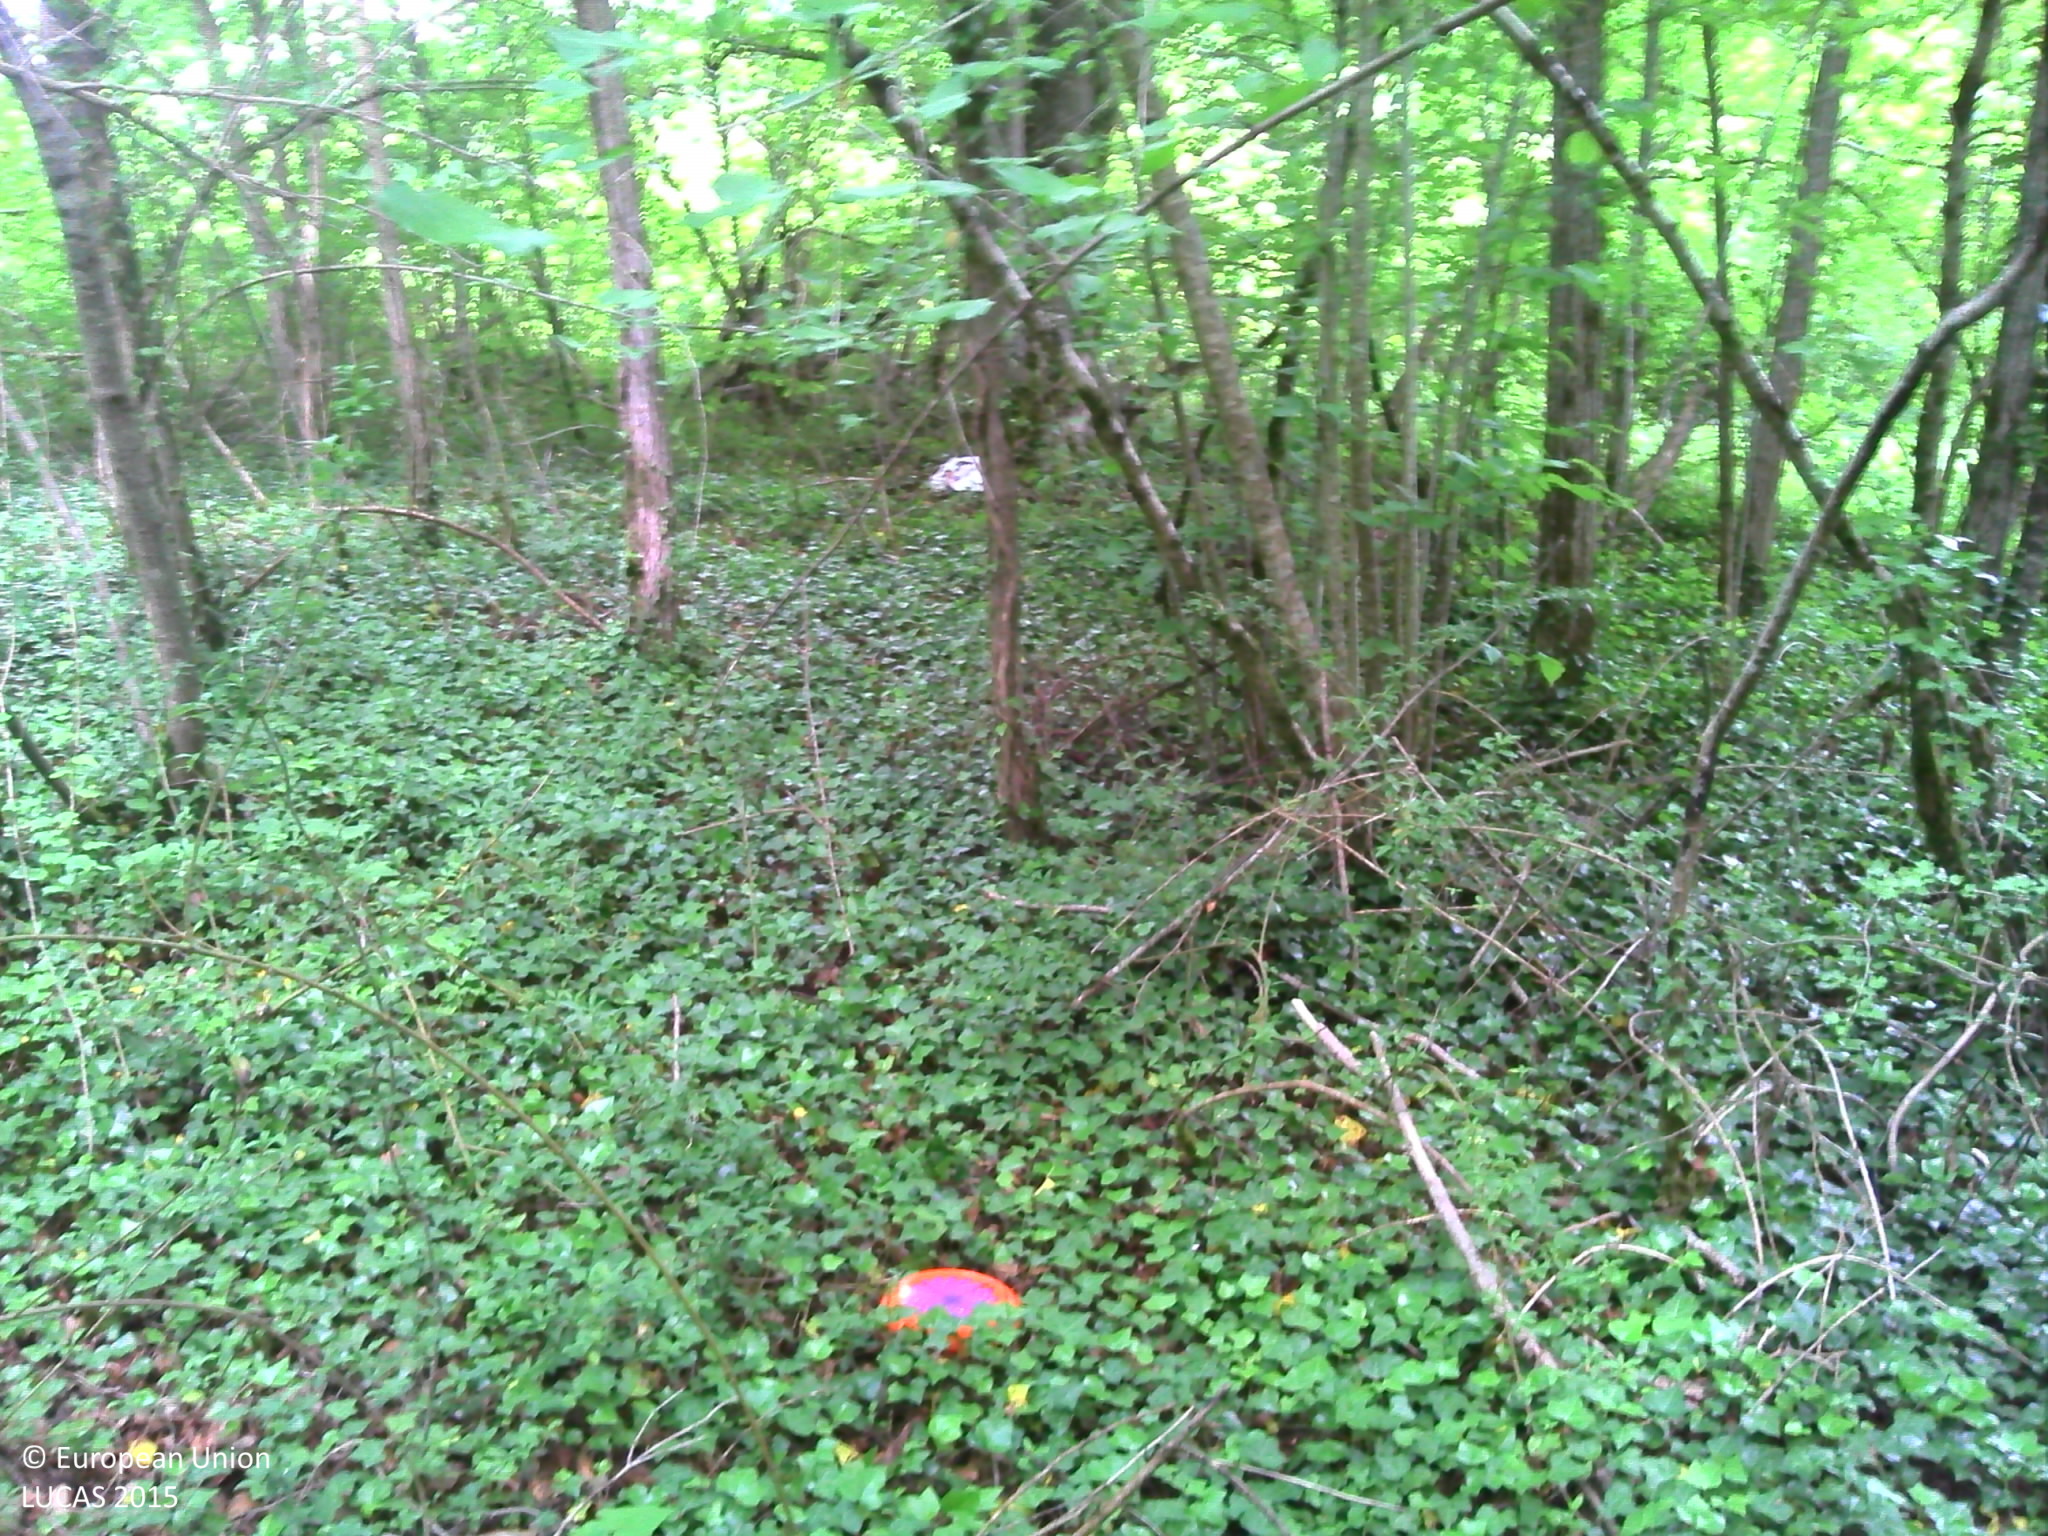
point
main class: Woodland
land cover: Broadleaved woodland
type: acidophilous oak and oak-birch forest
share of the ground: > 75 %
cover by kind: broadleaved forest trees 90 %, herbaceous plants 5 %, lichens and mosses 5 %
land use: Forestry
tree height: > 5 m
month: May
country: FR
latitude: 47.7860
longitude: 4.2718
